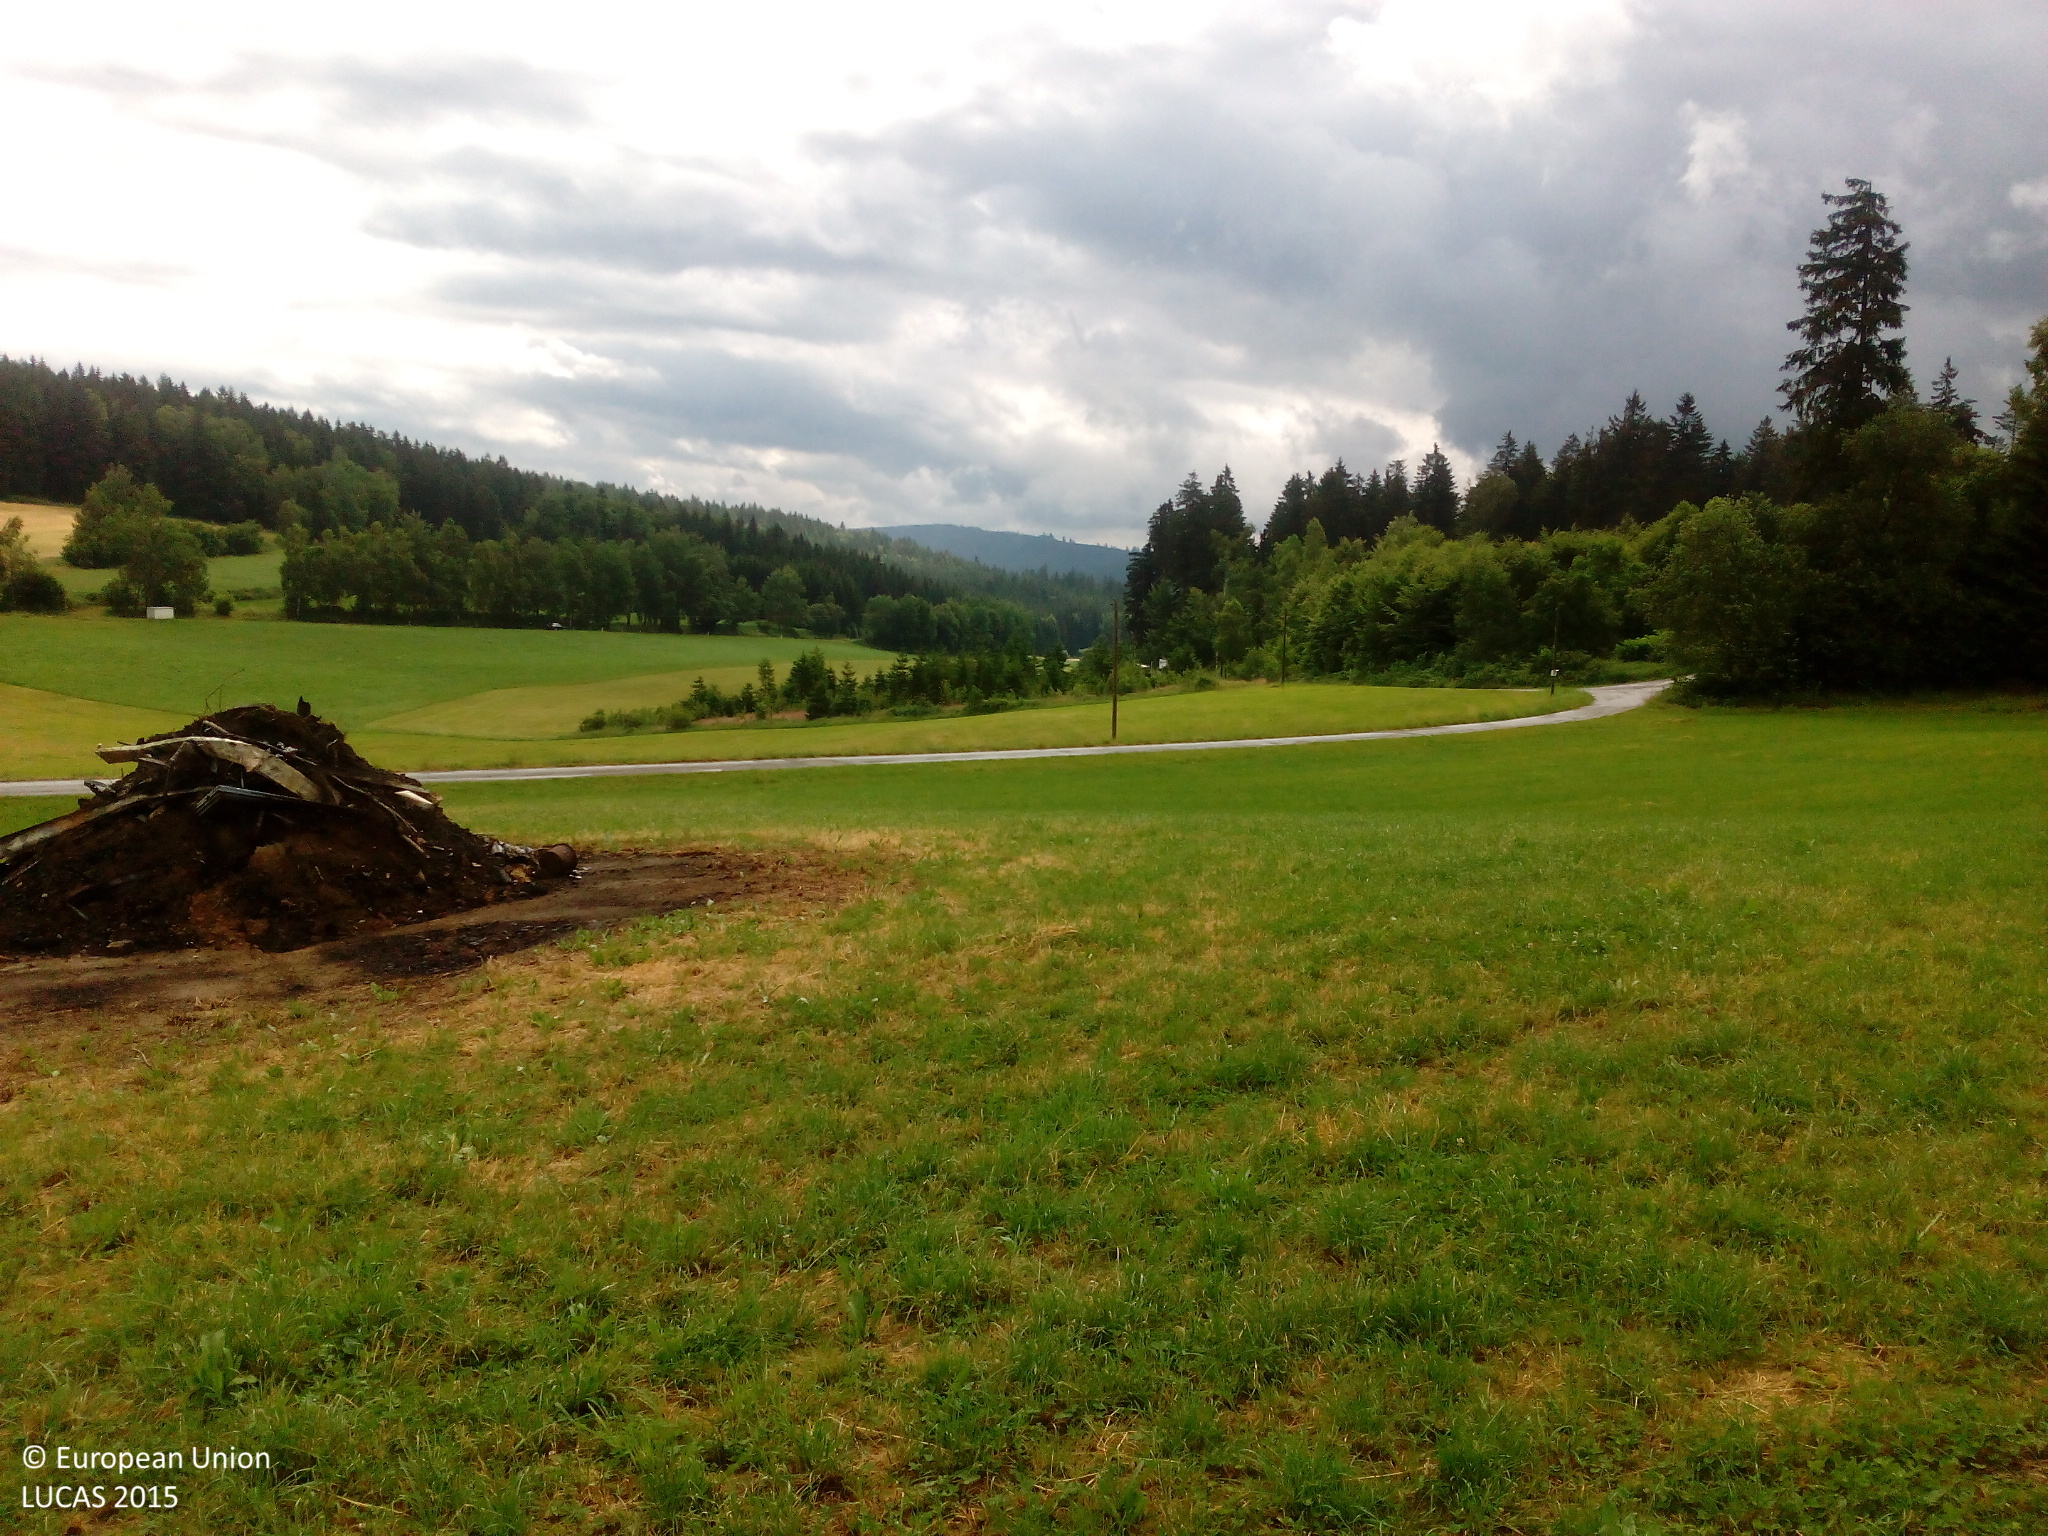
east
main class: Grassland
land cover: Grassland without tree/shrub cover
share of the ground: > 75 %
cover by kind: herbaceous plants 95 %, unconsolidated bare surface 5 %
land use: Agriculture (excluding fallow land and kitchen gardens)
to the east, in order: Grassland without tree/shrub cover; Other bare soil; Grassland without tree/shrub cover; Paved roads, cycling and walking lanes; Grass margins; Electric lines; Grassland without tree/shrub cover; Shrubland with sparse tree cover; Spruce dominated coniferous woodland; Shrubland without tree cover; Grassland without tree/shrub cover
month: July
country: DE
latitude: 49.6739
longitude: 12.3692
